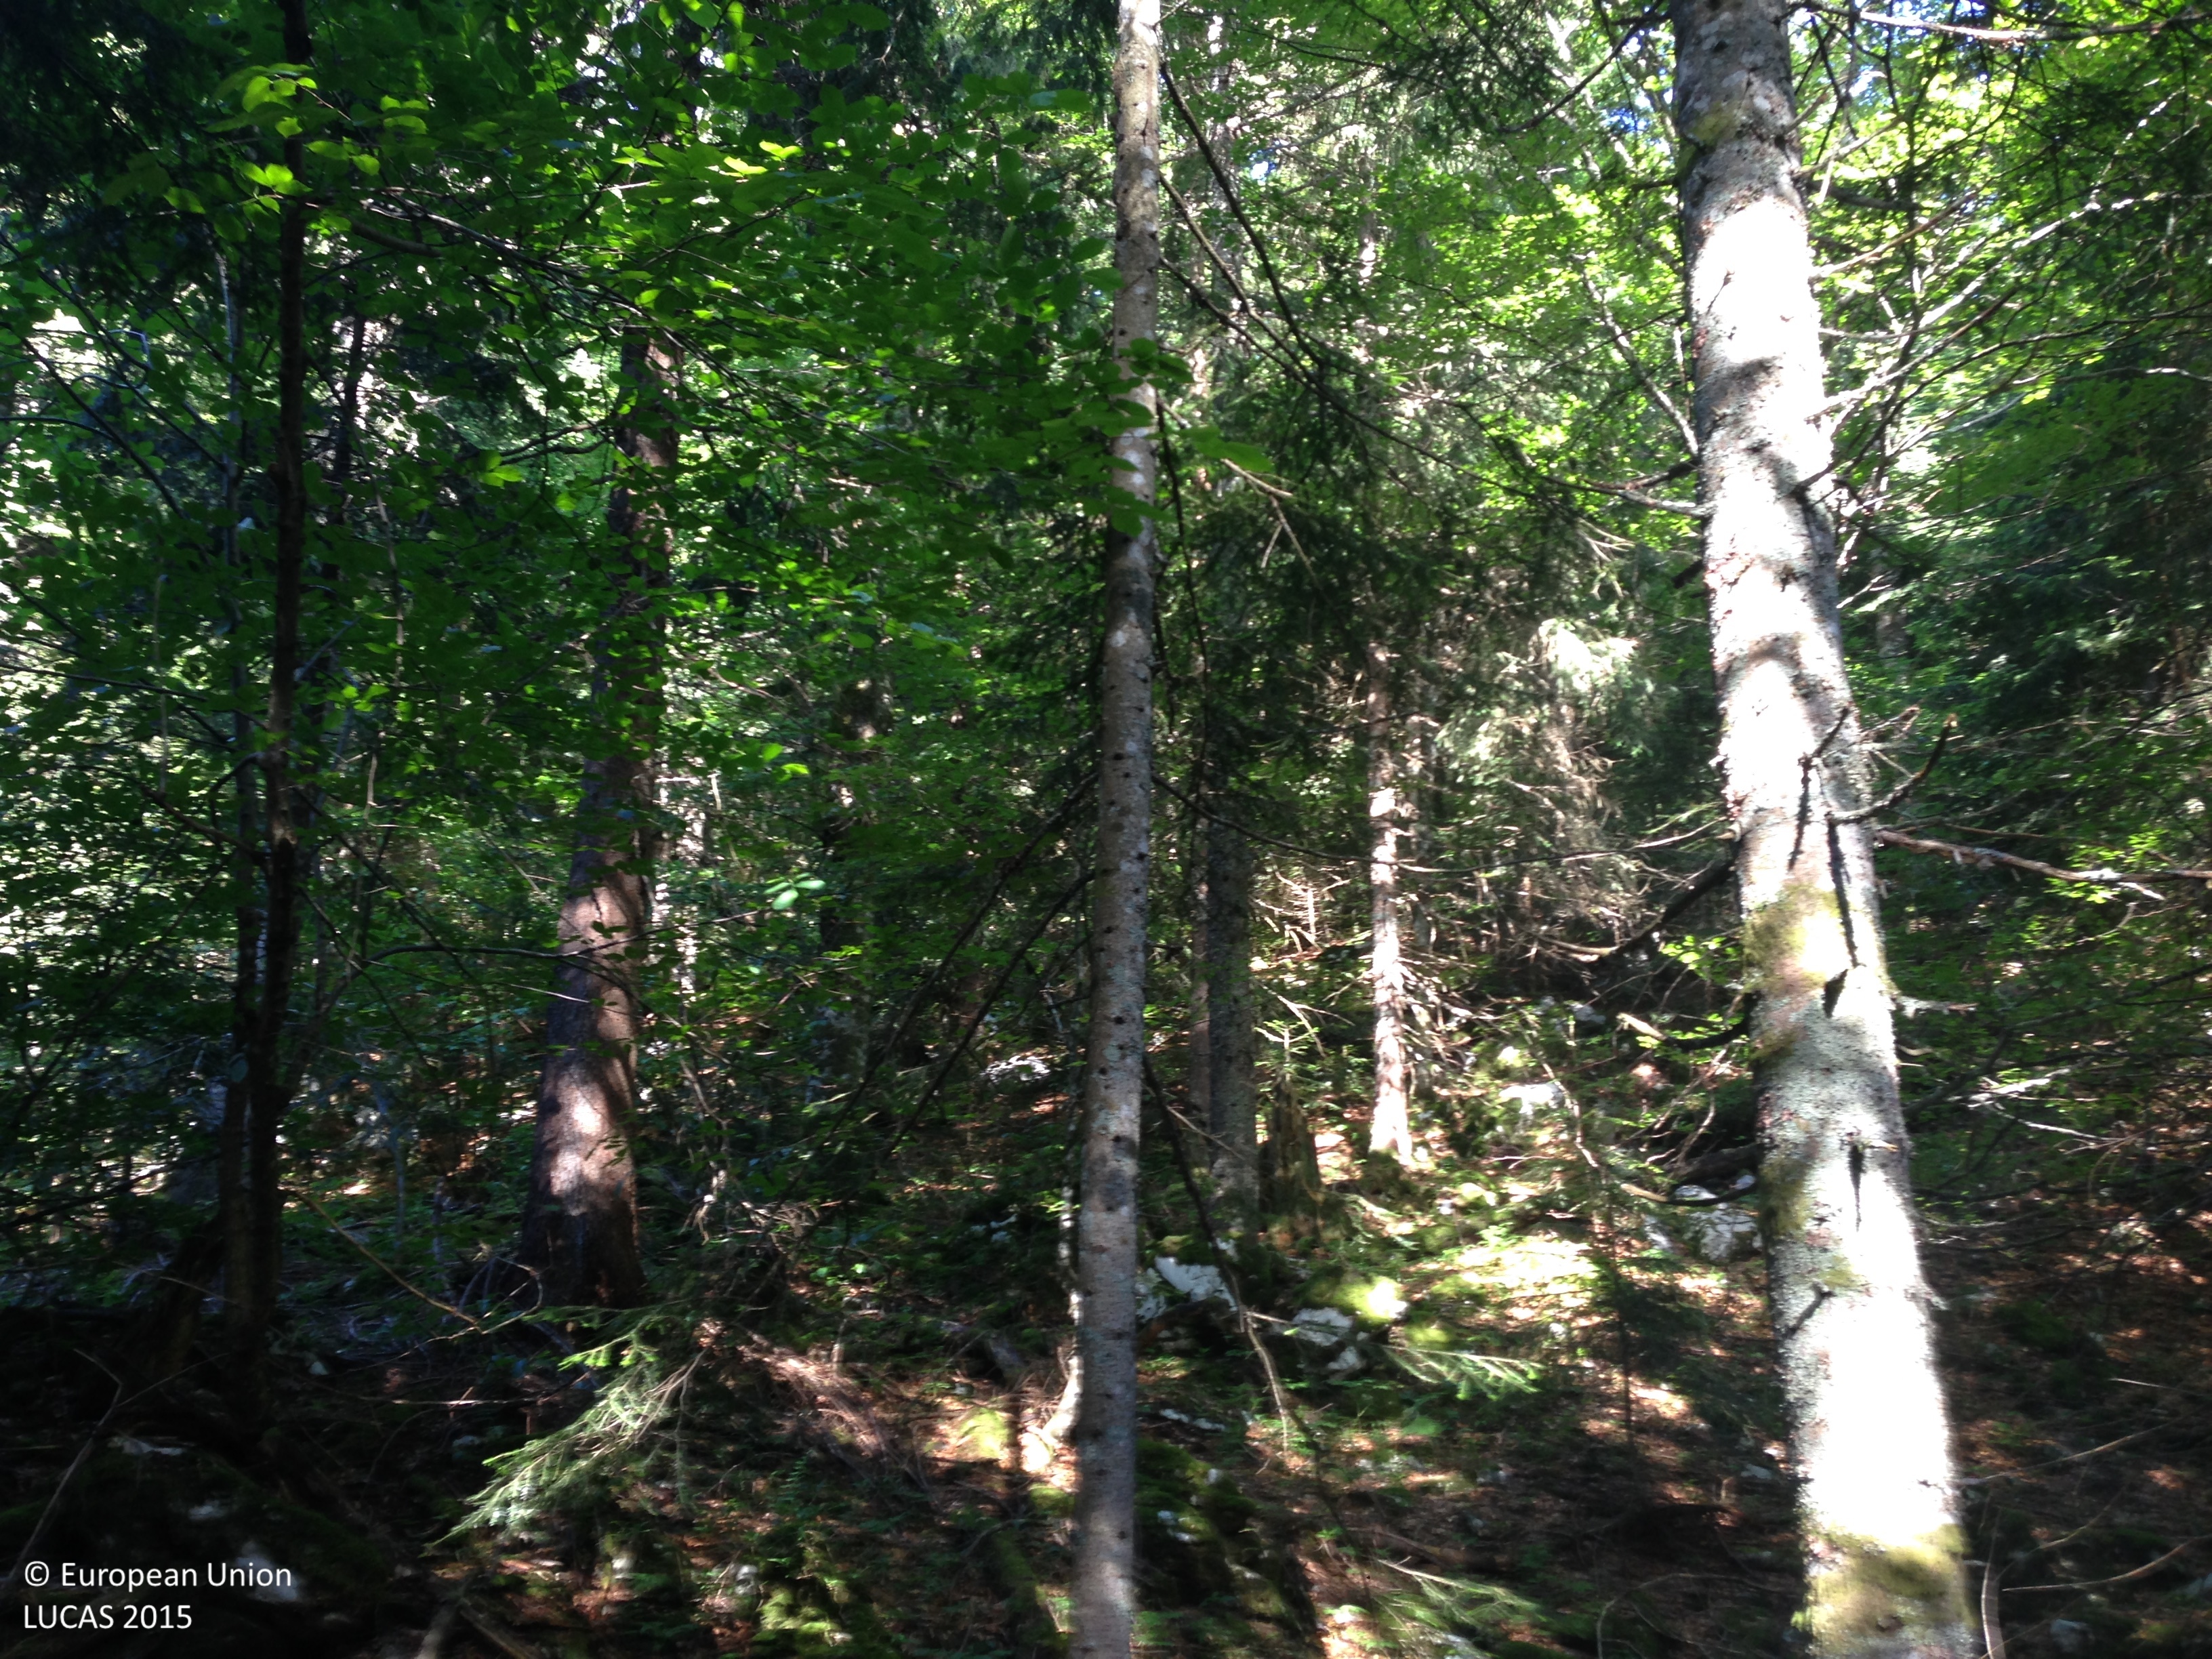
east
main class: Woodland
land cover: Other mixed woodland
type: thermophilous deciduous forest
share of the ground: > 75 %
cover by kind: broadleaved forest trees 45 %, coniferous forest trees 30 %, herbaceous plants 10 %, shrubs 5 %, lichens and mosses 5 %, unconsolidated bare surface 5 %
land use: Forestry
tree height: > 5 m
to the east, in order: Other mixed woodland; Tracks; Other mixed woodland; Tracks; Other mixed woodland
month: June
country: HR
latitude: 44.6385
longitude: 15.8311
